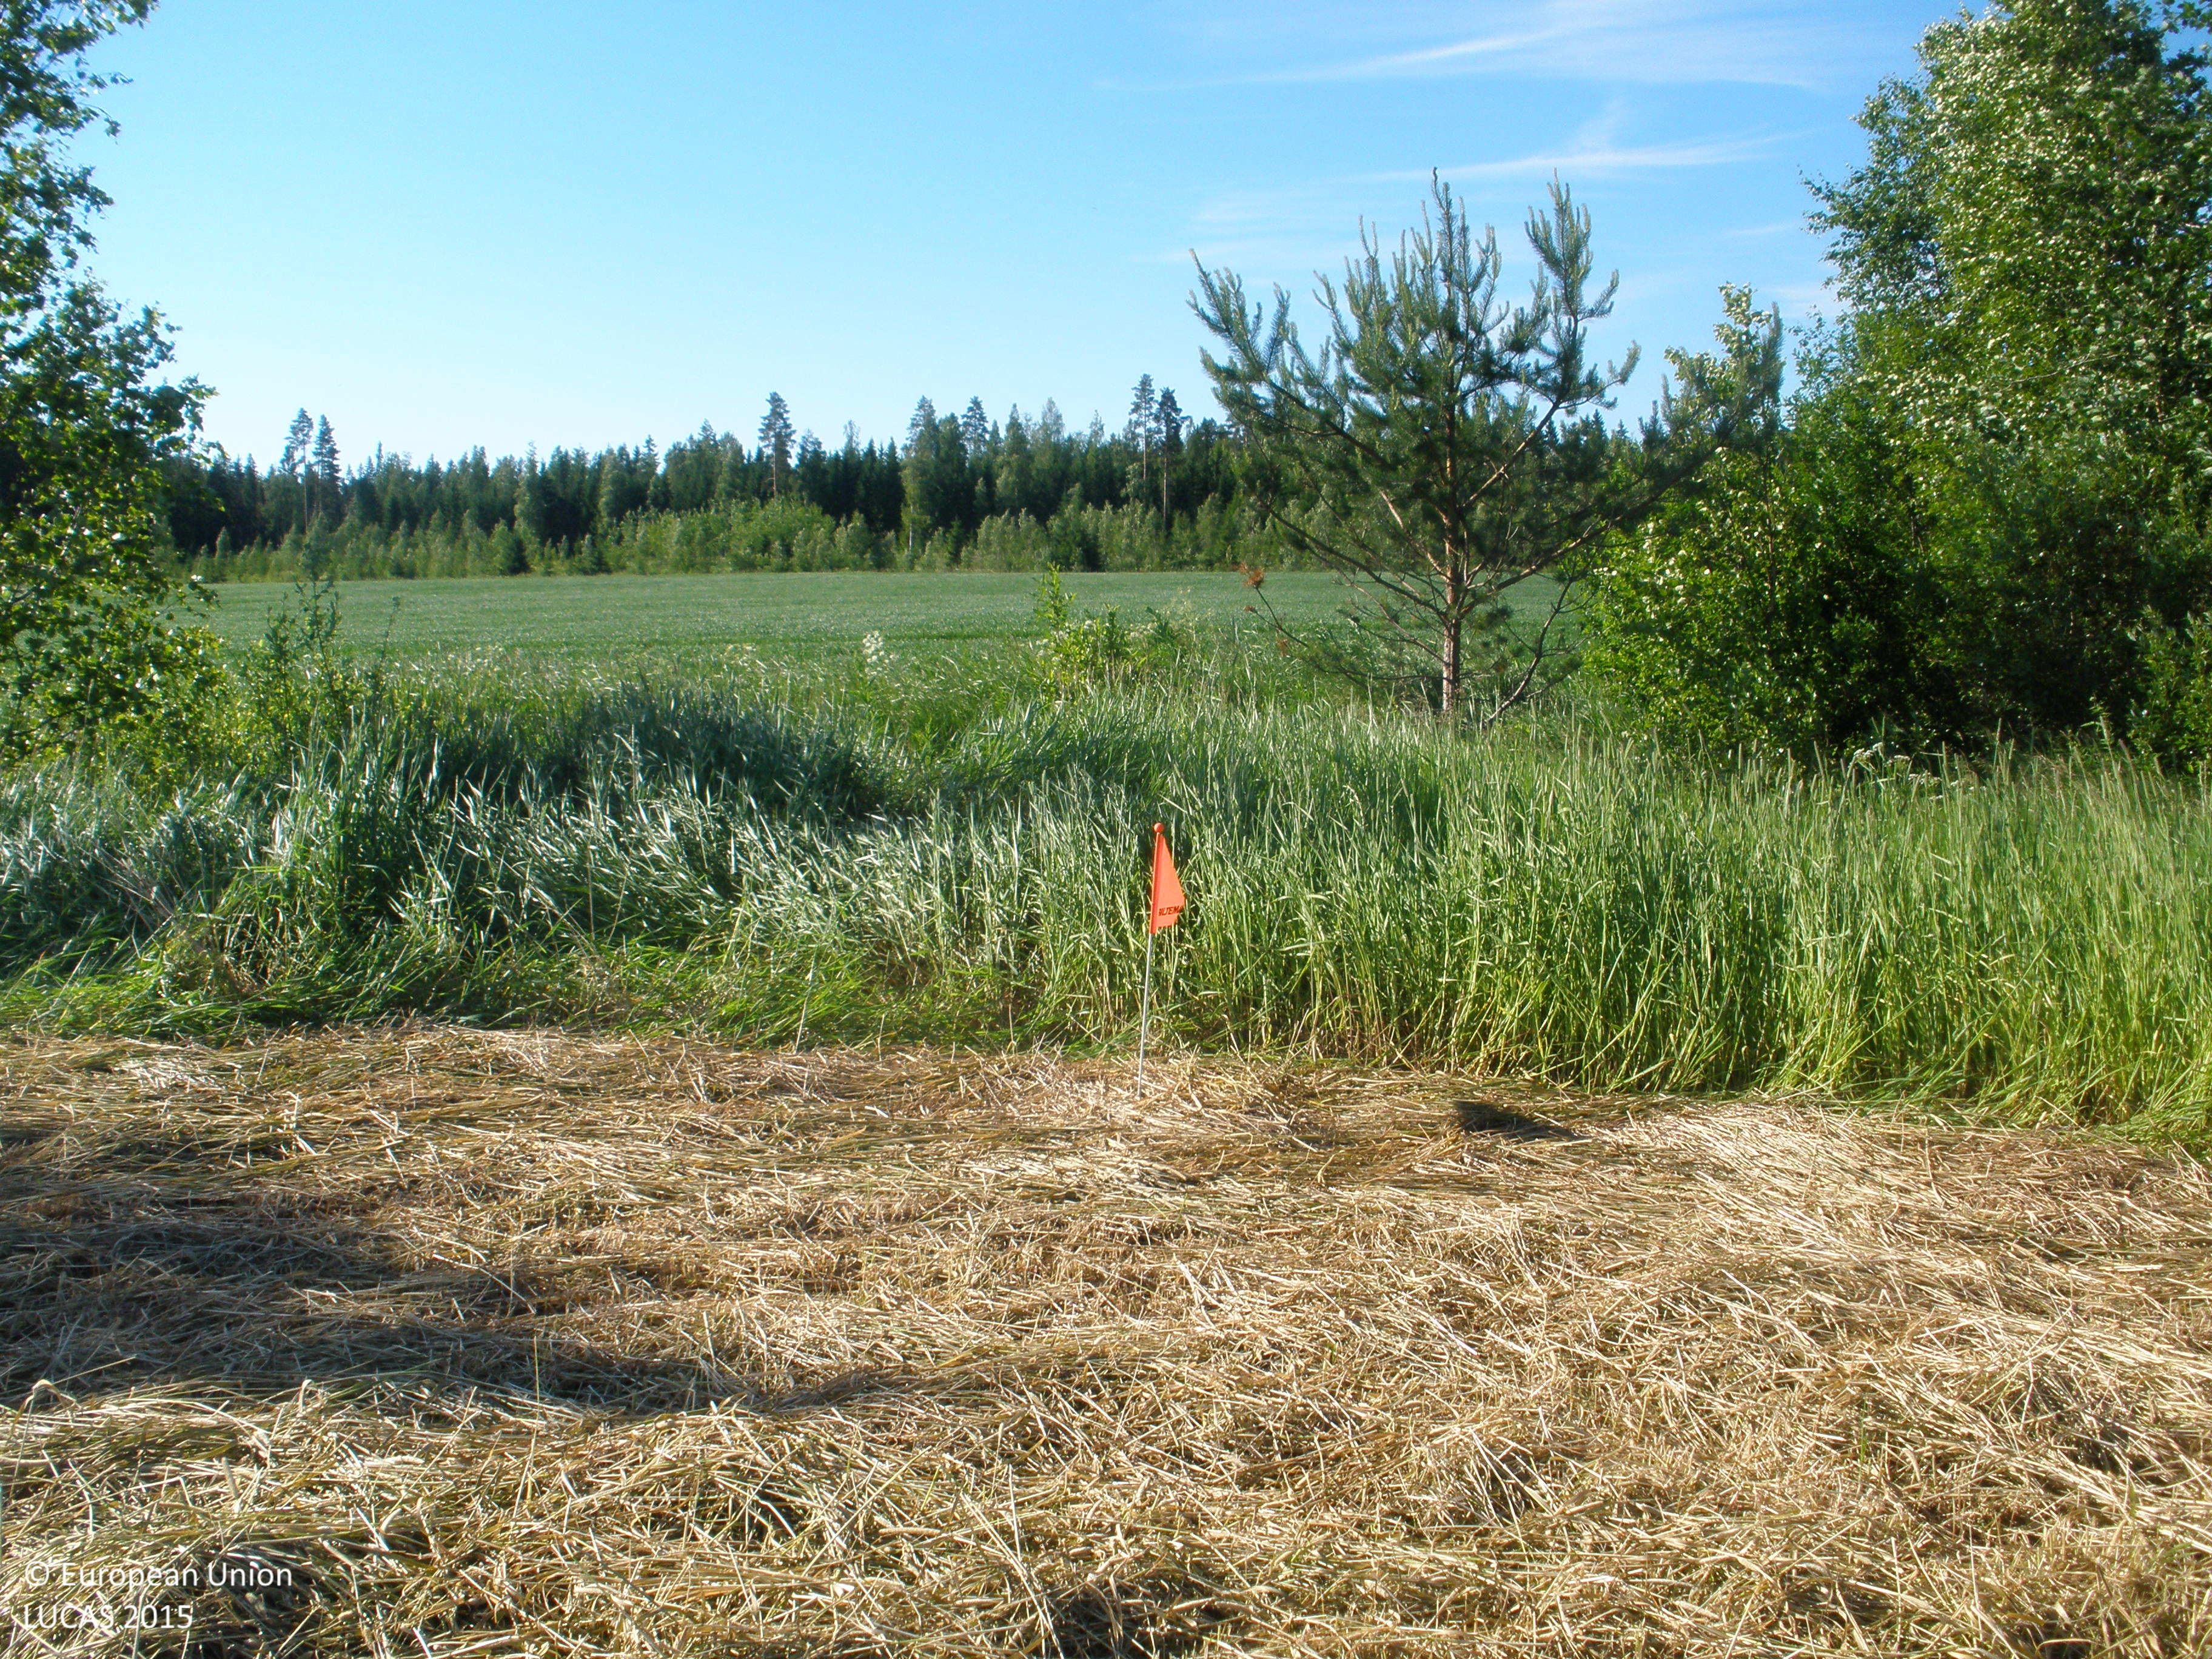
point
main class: Cropland
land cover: Mixed cereals for fodder
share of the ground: 25 - 50 %
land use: Agriculture (excluding fallow land and kitchen gardens)
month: July
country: FI
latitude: 61.2302
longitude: 23.8903
